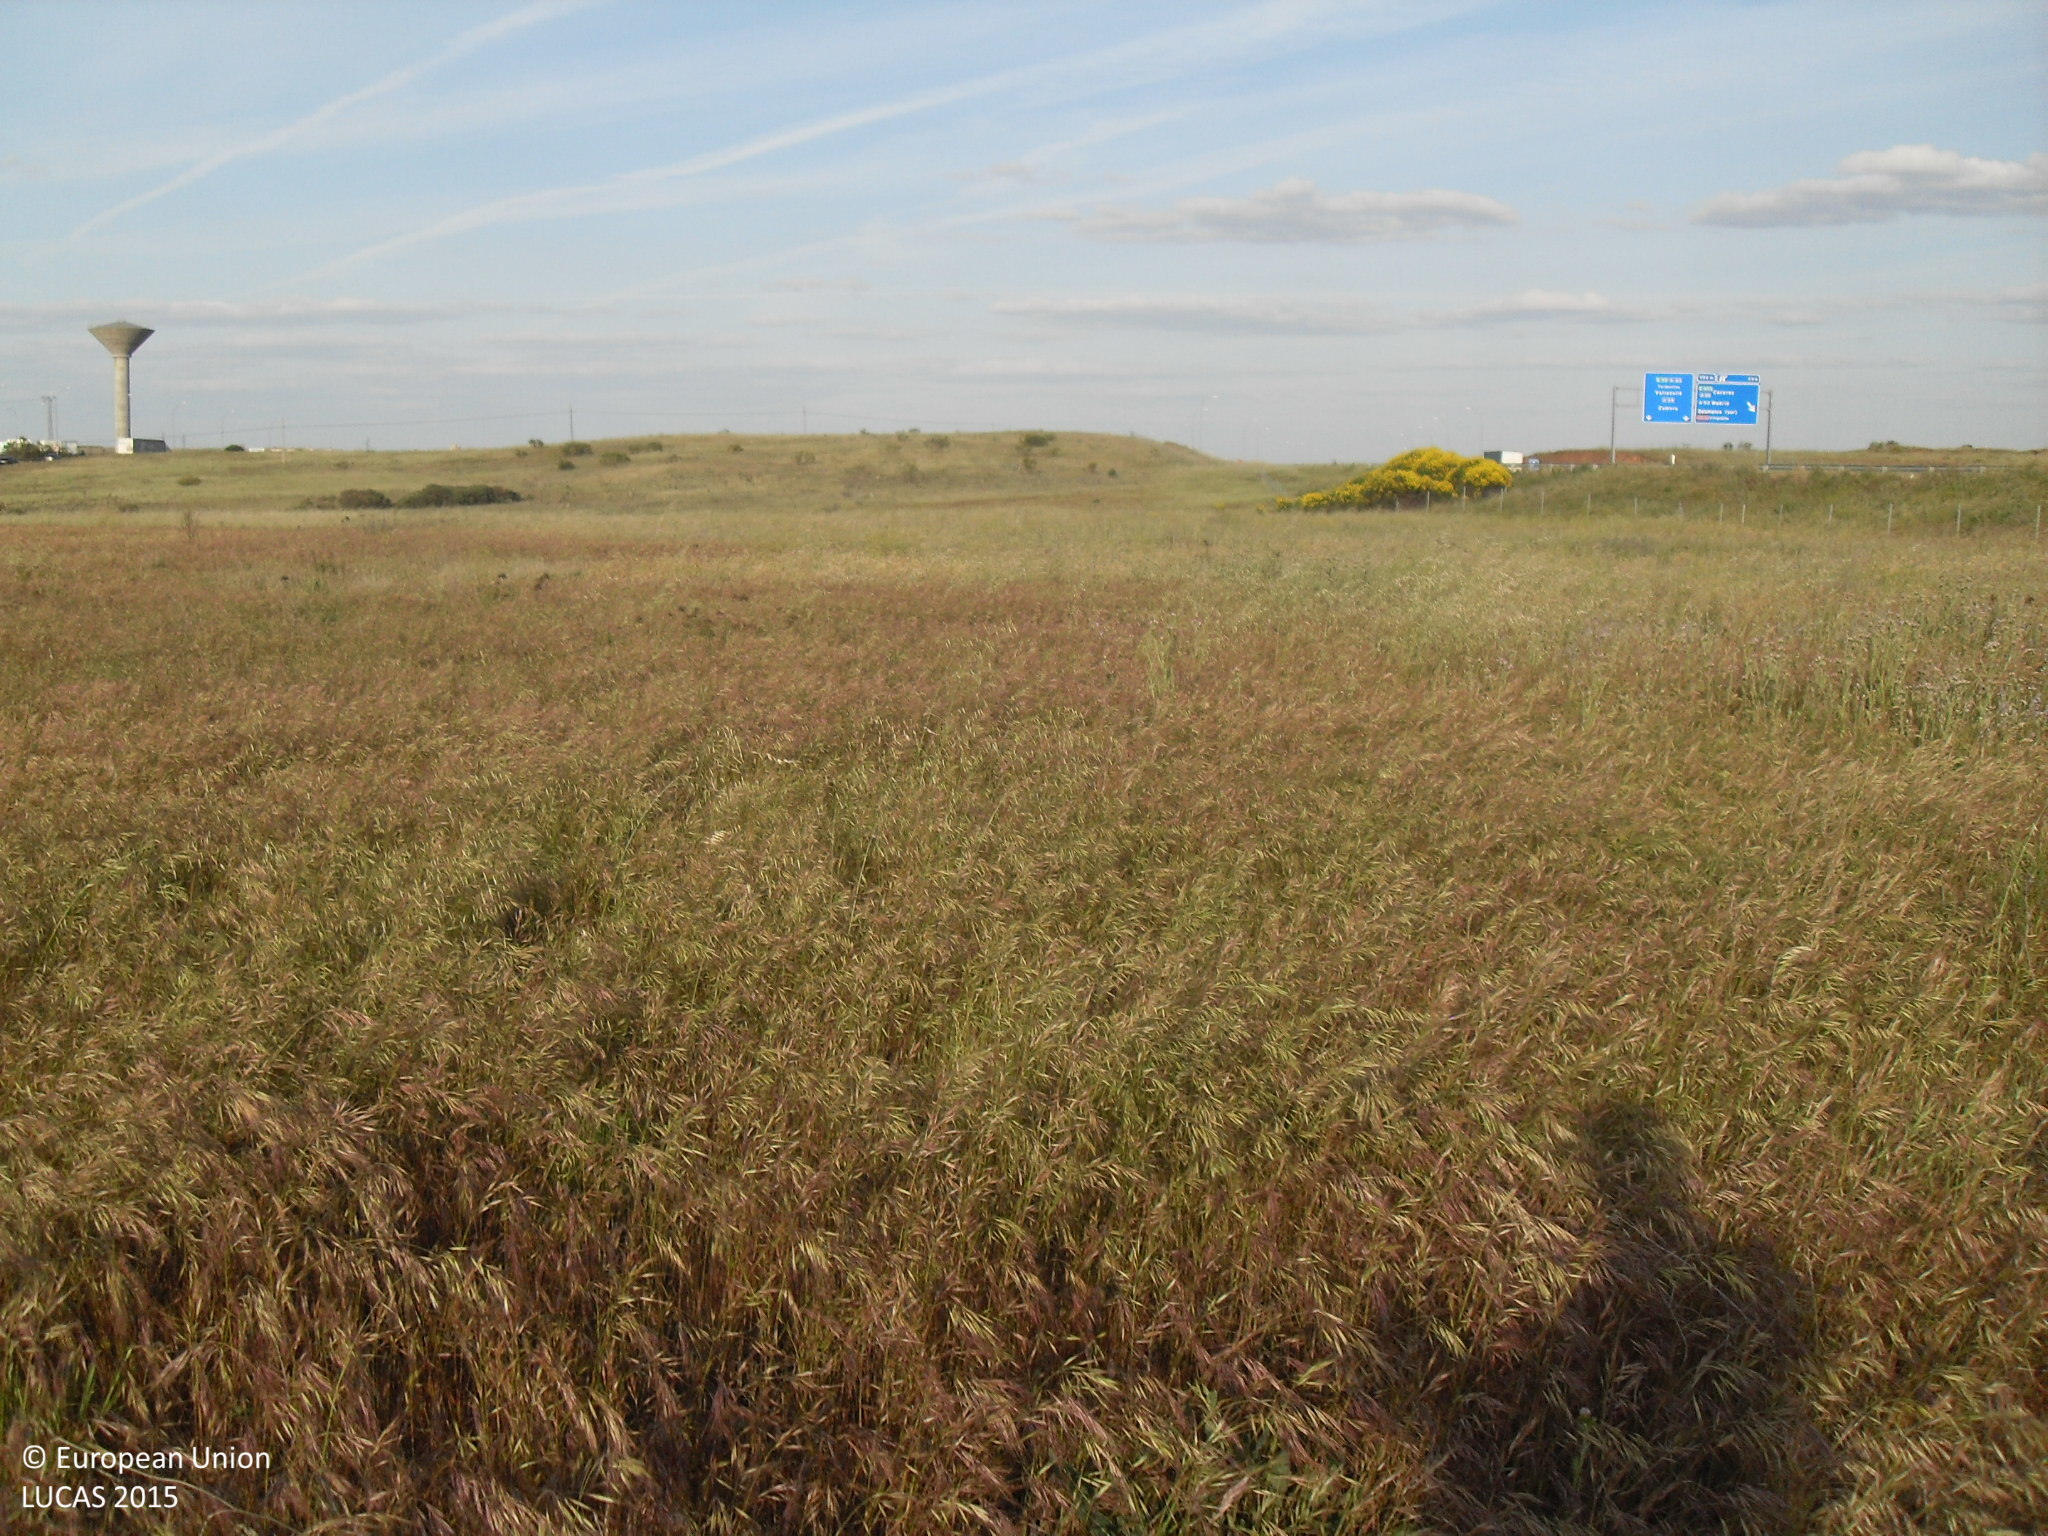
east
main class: Grassland
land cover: Grassland without tree/shrub cover
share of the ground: > 75 %
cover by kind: herbaceous plants 100 %
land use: Agriculture (excluding fallow land and kitchen gardens)
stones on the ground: 10 - 25 %
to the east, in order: Grassland without tree/shrub cover; Ditches and canals; Grassland without tree/shrub cover
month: May
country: ES
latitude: 40.9574
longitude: -5.7254
